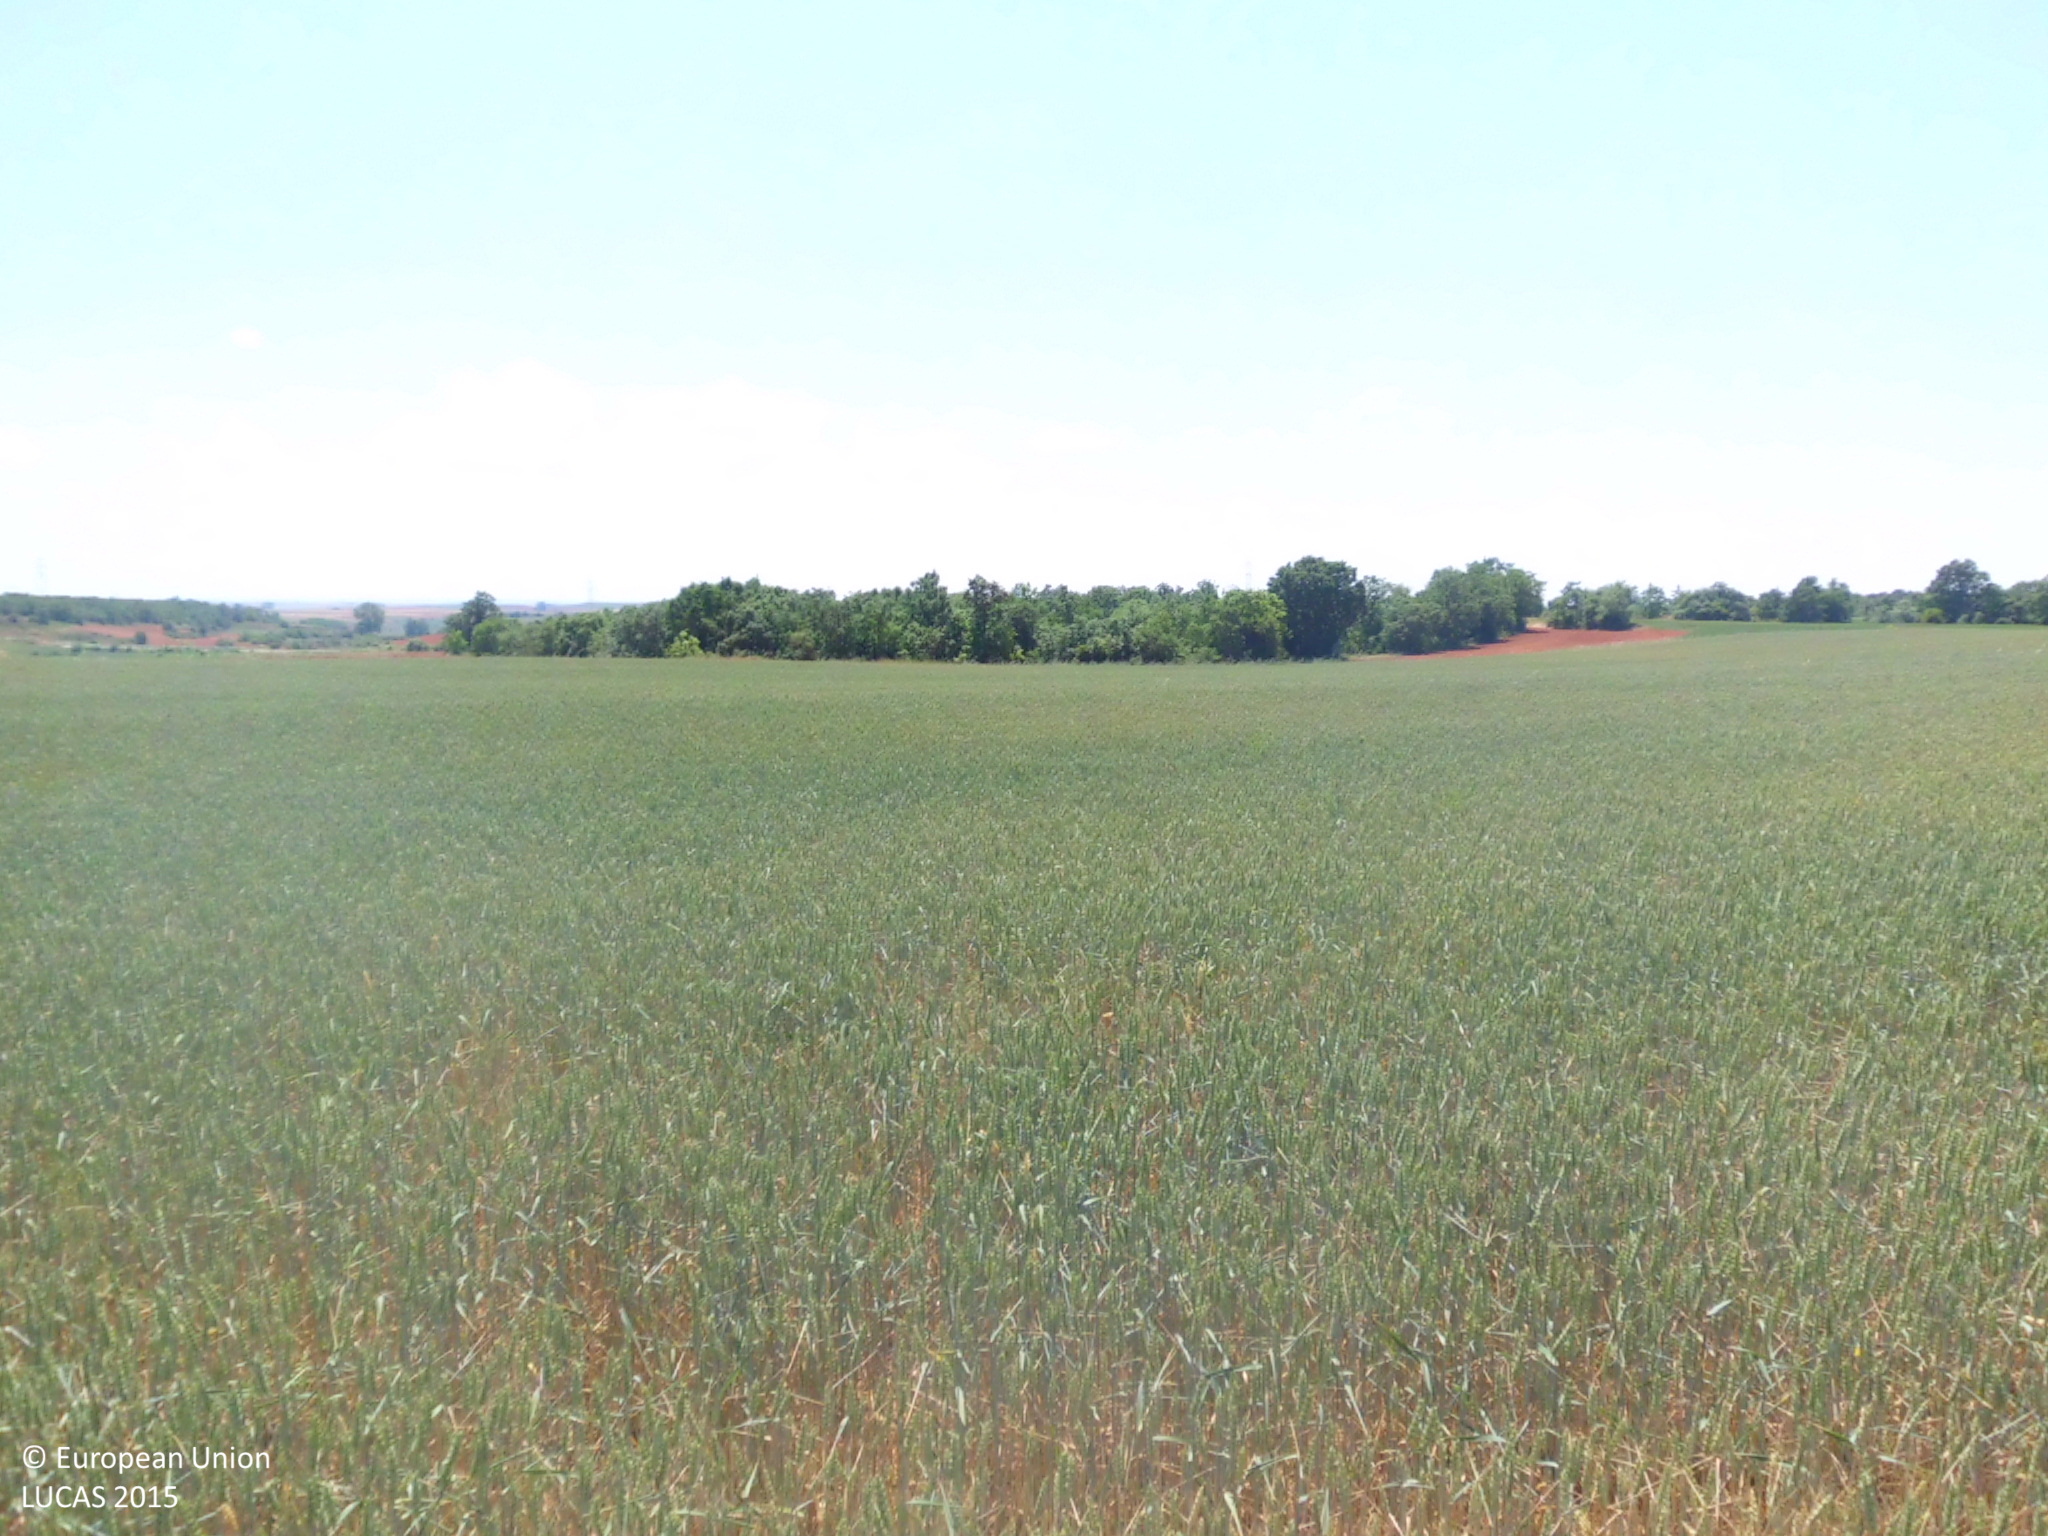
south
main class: Cropland
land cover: Common wheat
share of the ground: > 75 %
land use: Agriculture (excluding fallow land and kitchen gardens)
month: June
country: ES
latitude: 42.5933
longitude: -4.2451
